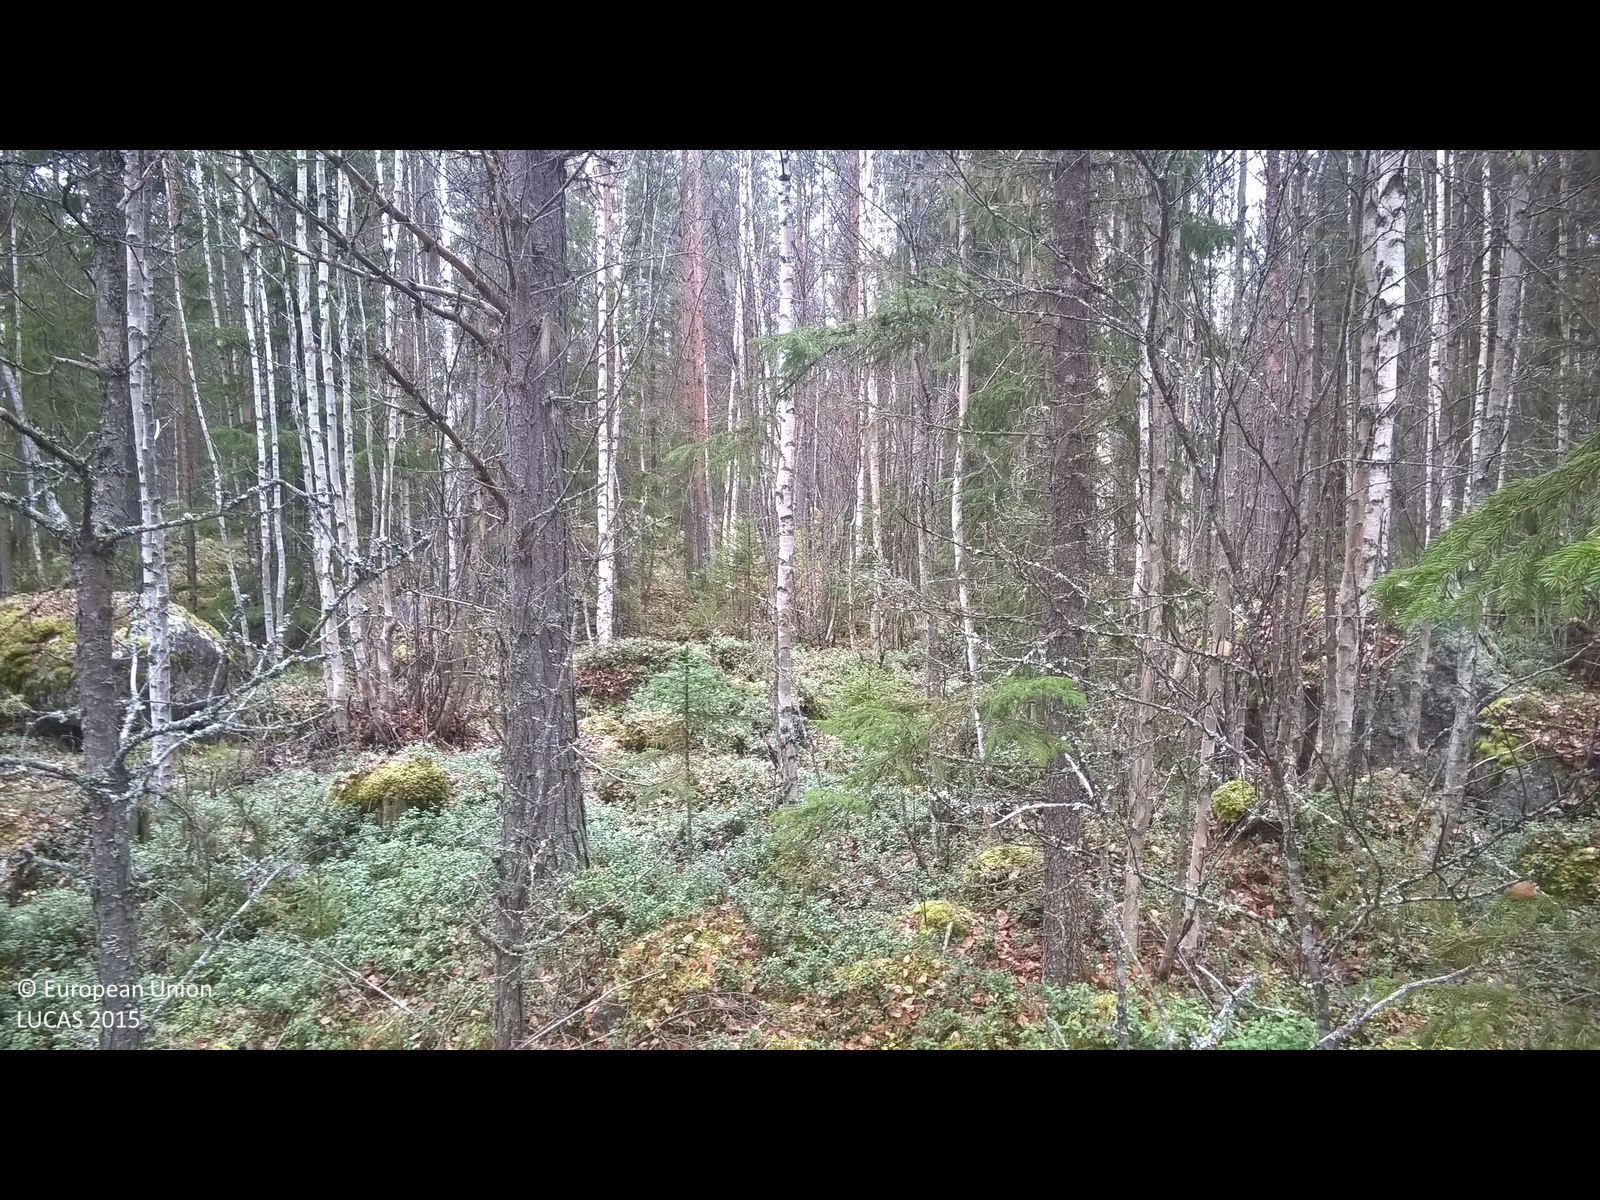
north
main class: Woodland
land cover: Other mixed woodland
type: boreal forest
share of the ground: > 75 %
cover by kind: coniferous forest trees 45 %, broadleaved forest trees 35 %, lichens and mosses 20 %
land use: Forestry
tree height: > 5 m
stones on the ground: 10 - 25 %
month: October
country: SE
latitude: 62.9037
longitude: 15.1541
